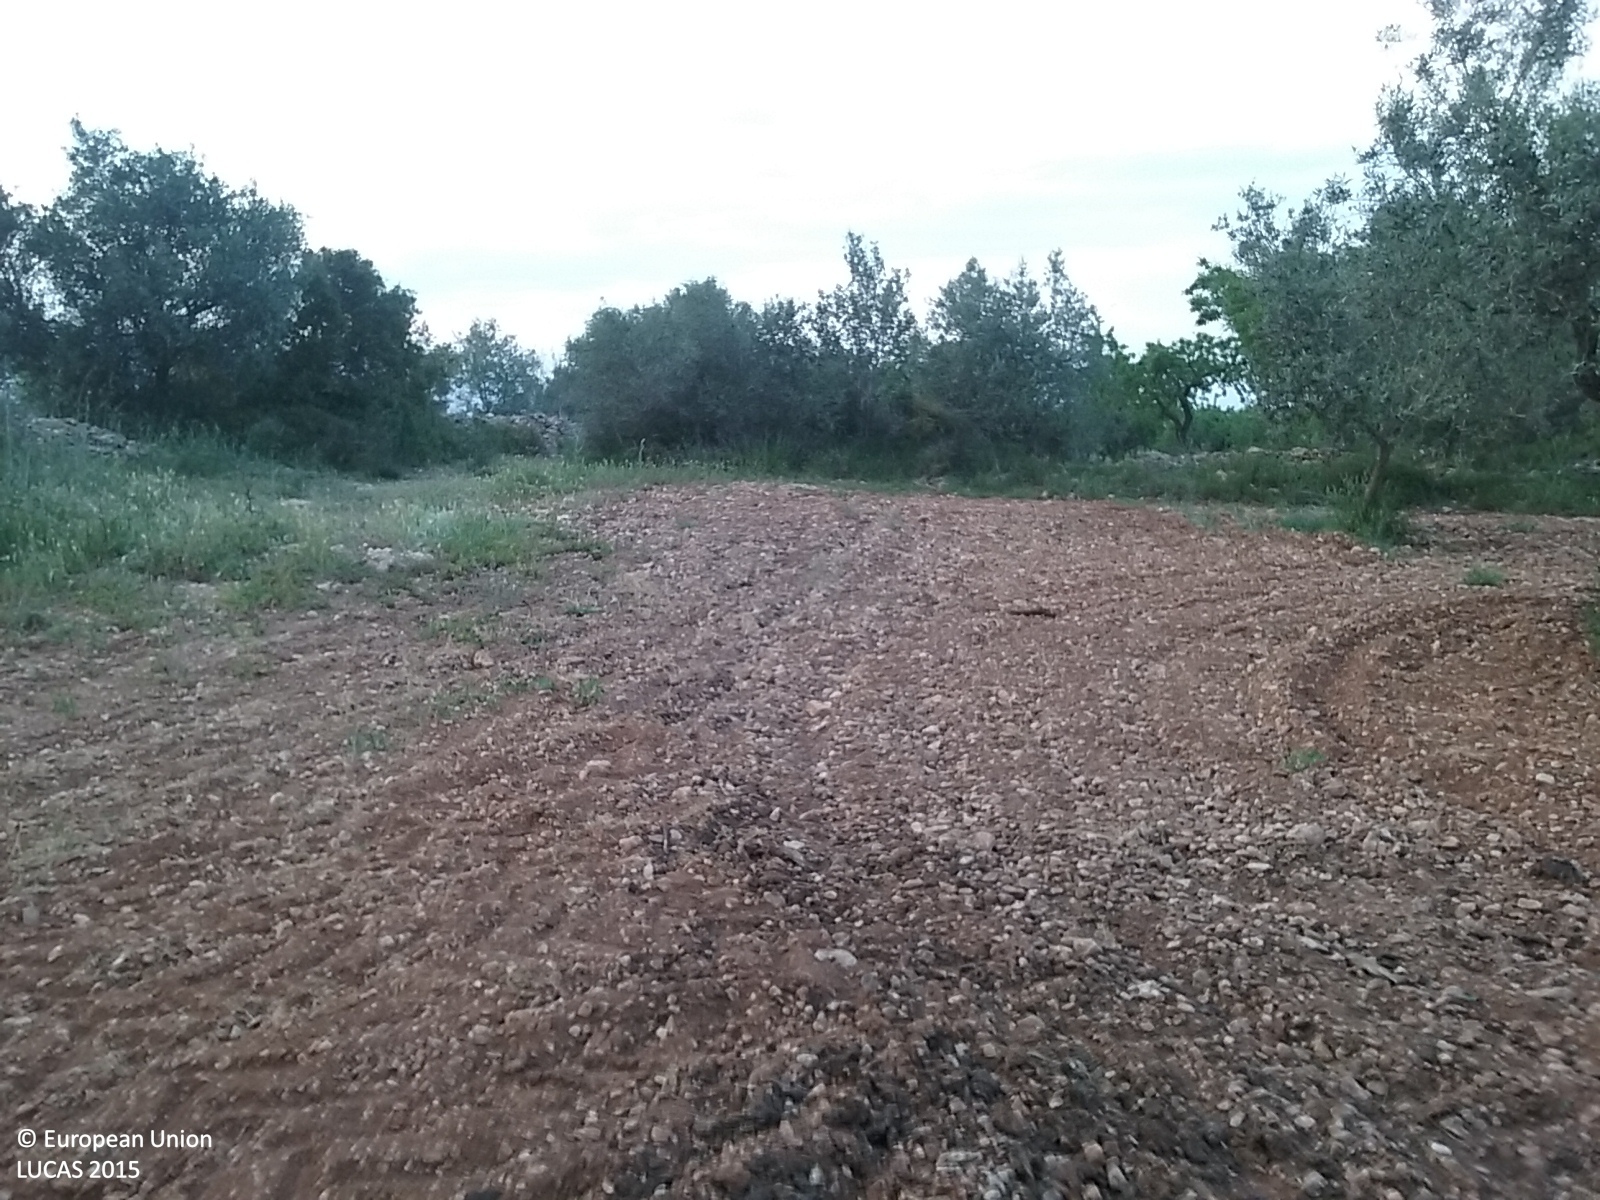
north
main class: Cropland
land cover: Olive groves
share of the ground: 25 - 50 %
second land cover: Other bare soil
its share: > 75 %
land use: Agriculture (excluding fallow land and kitchen gardens)
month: April
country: ES
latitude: 40.2940
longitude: 0.1033
